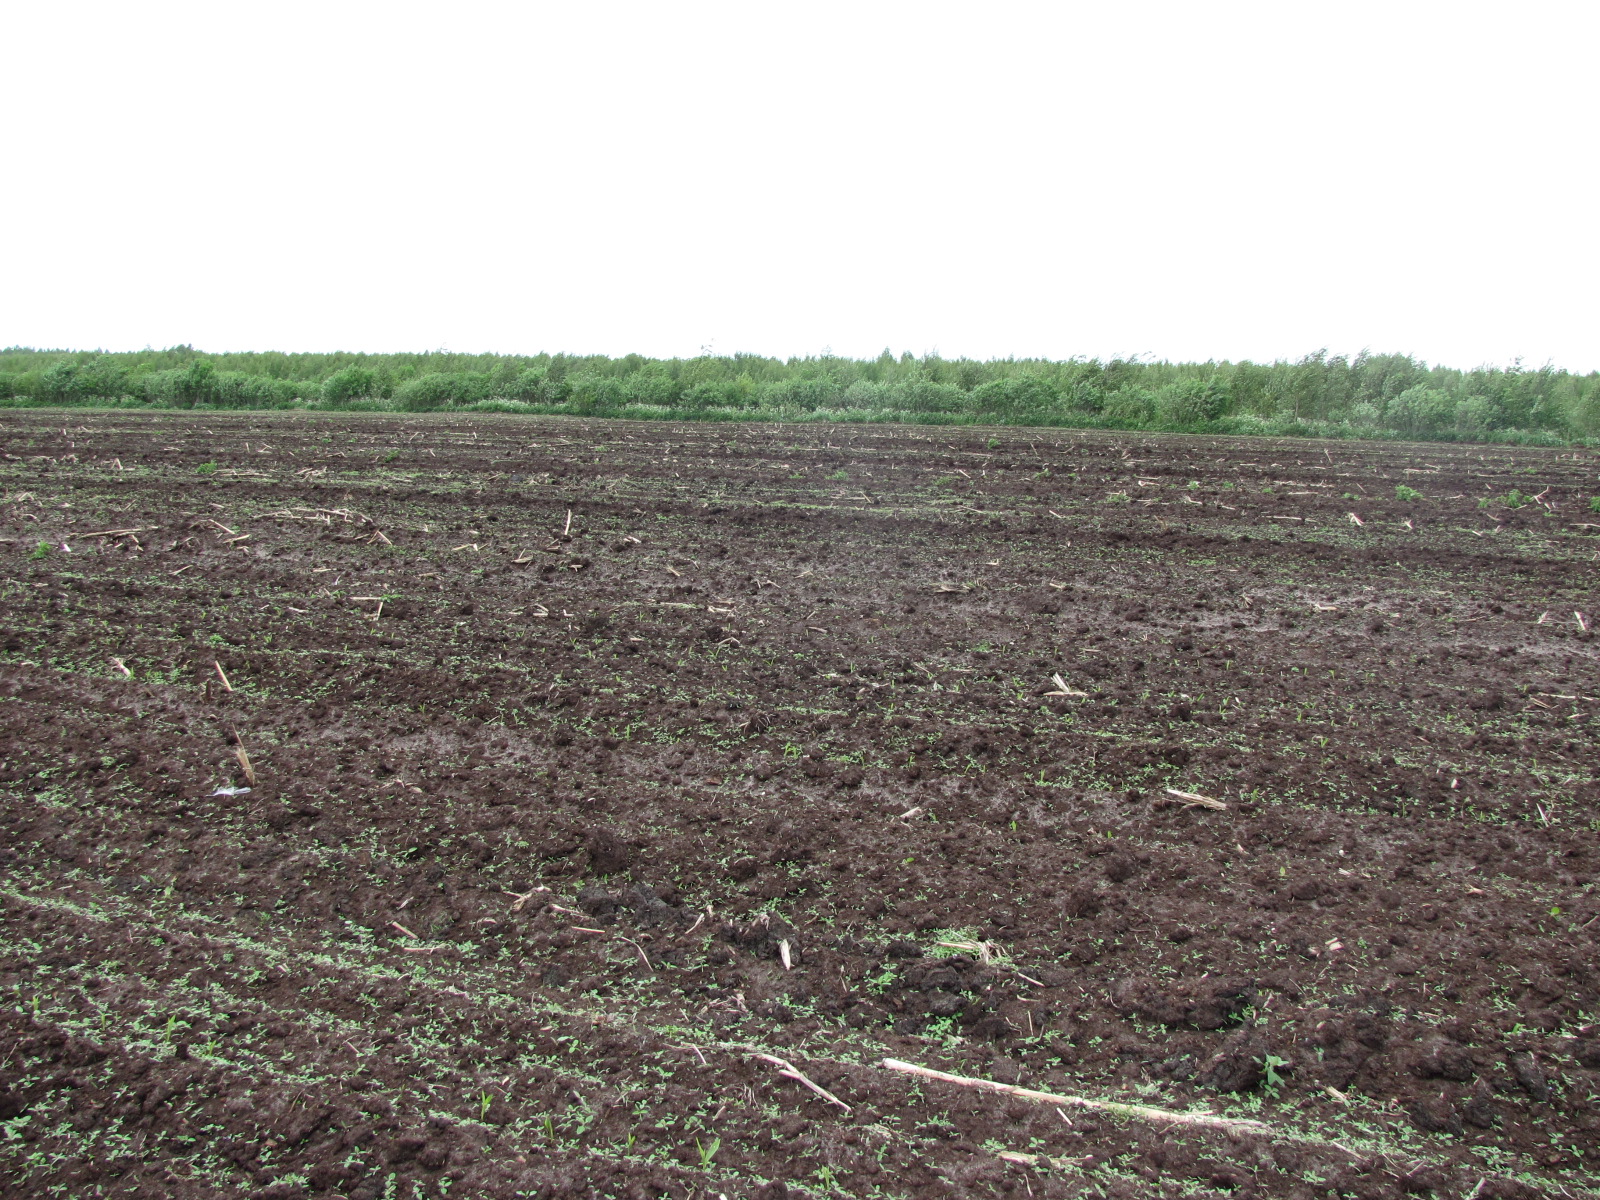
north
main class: Cropland
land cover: Maize
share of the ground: < 10 %
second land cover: Spontaneously vegetated surfaces
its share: 25 - 50 %
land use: Agriculture (excluding fallow land and kitchen gardens)
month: June
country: LV
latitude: 56.8587
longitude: 24.0077
